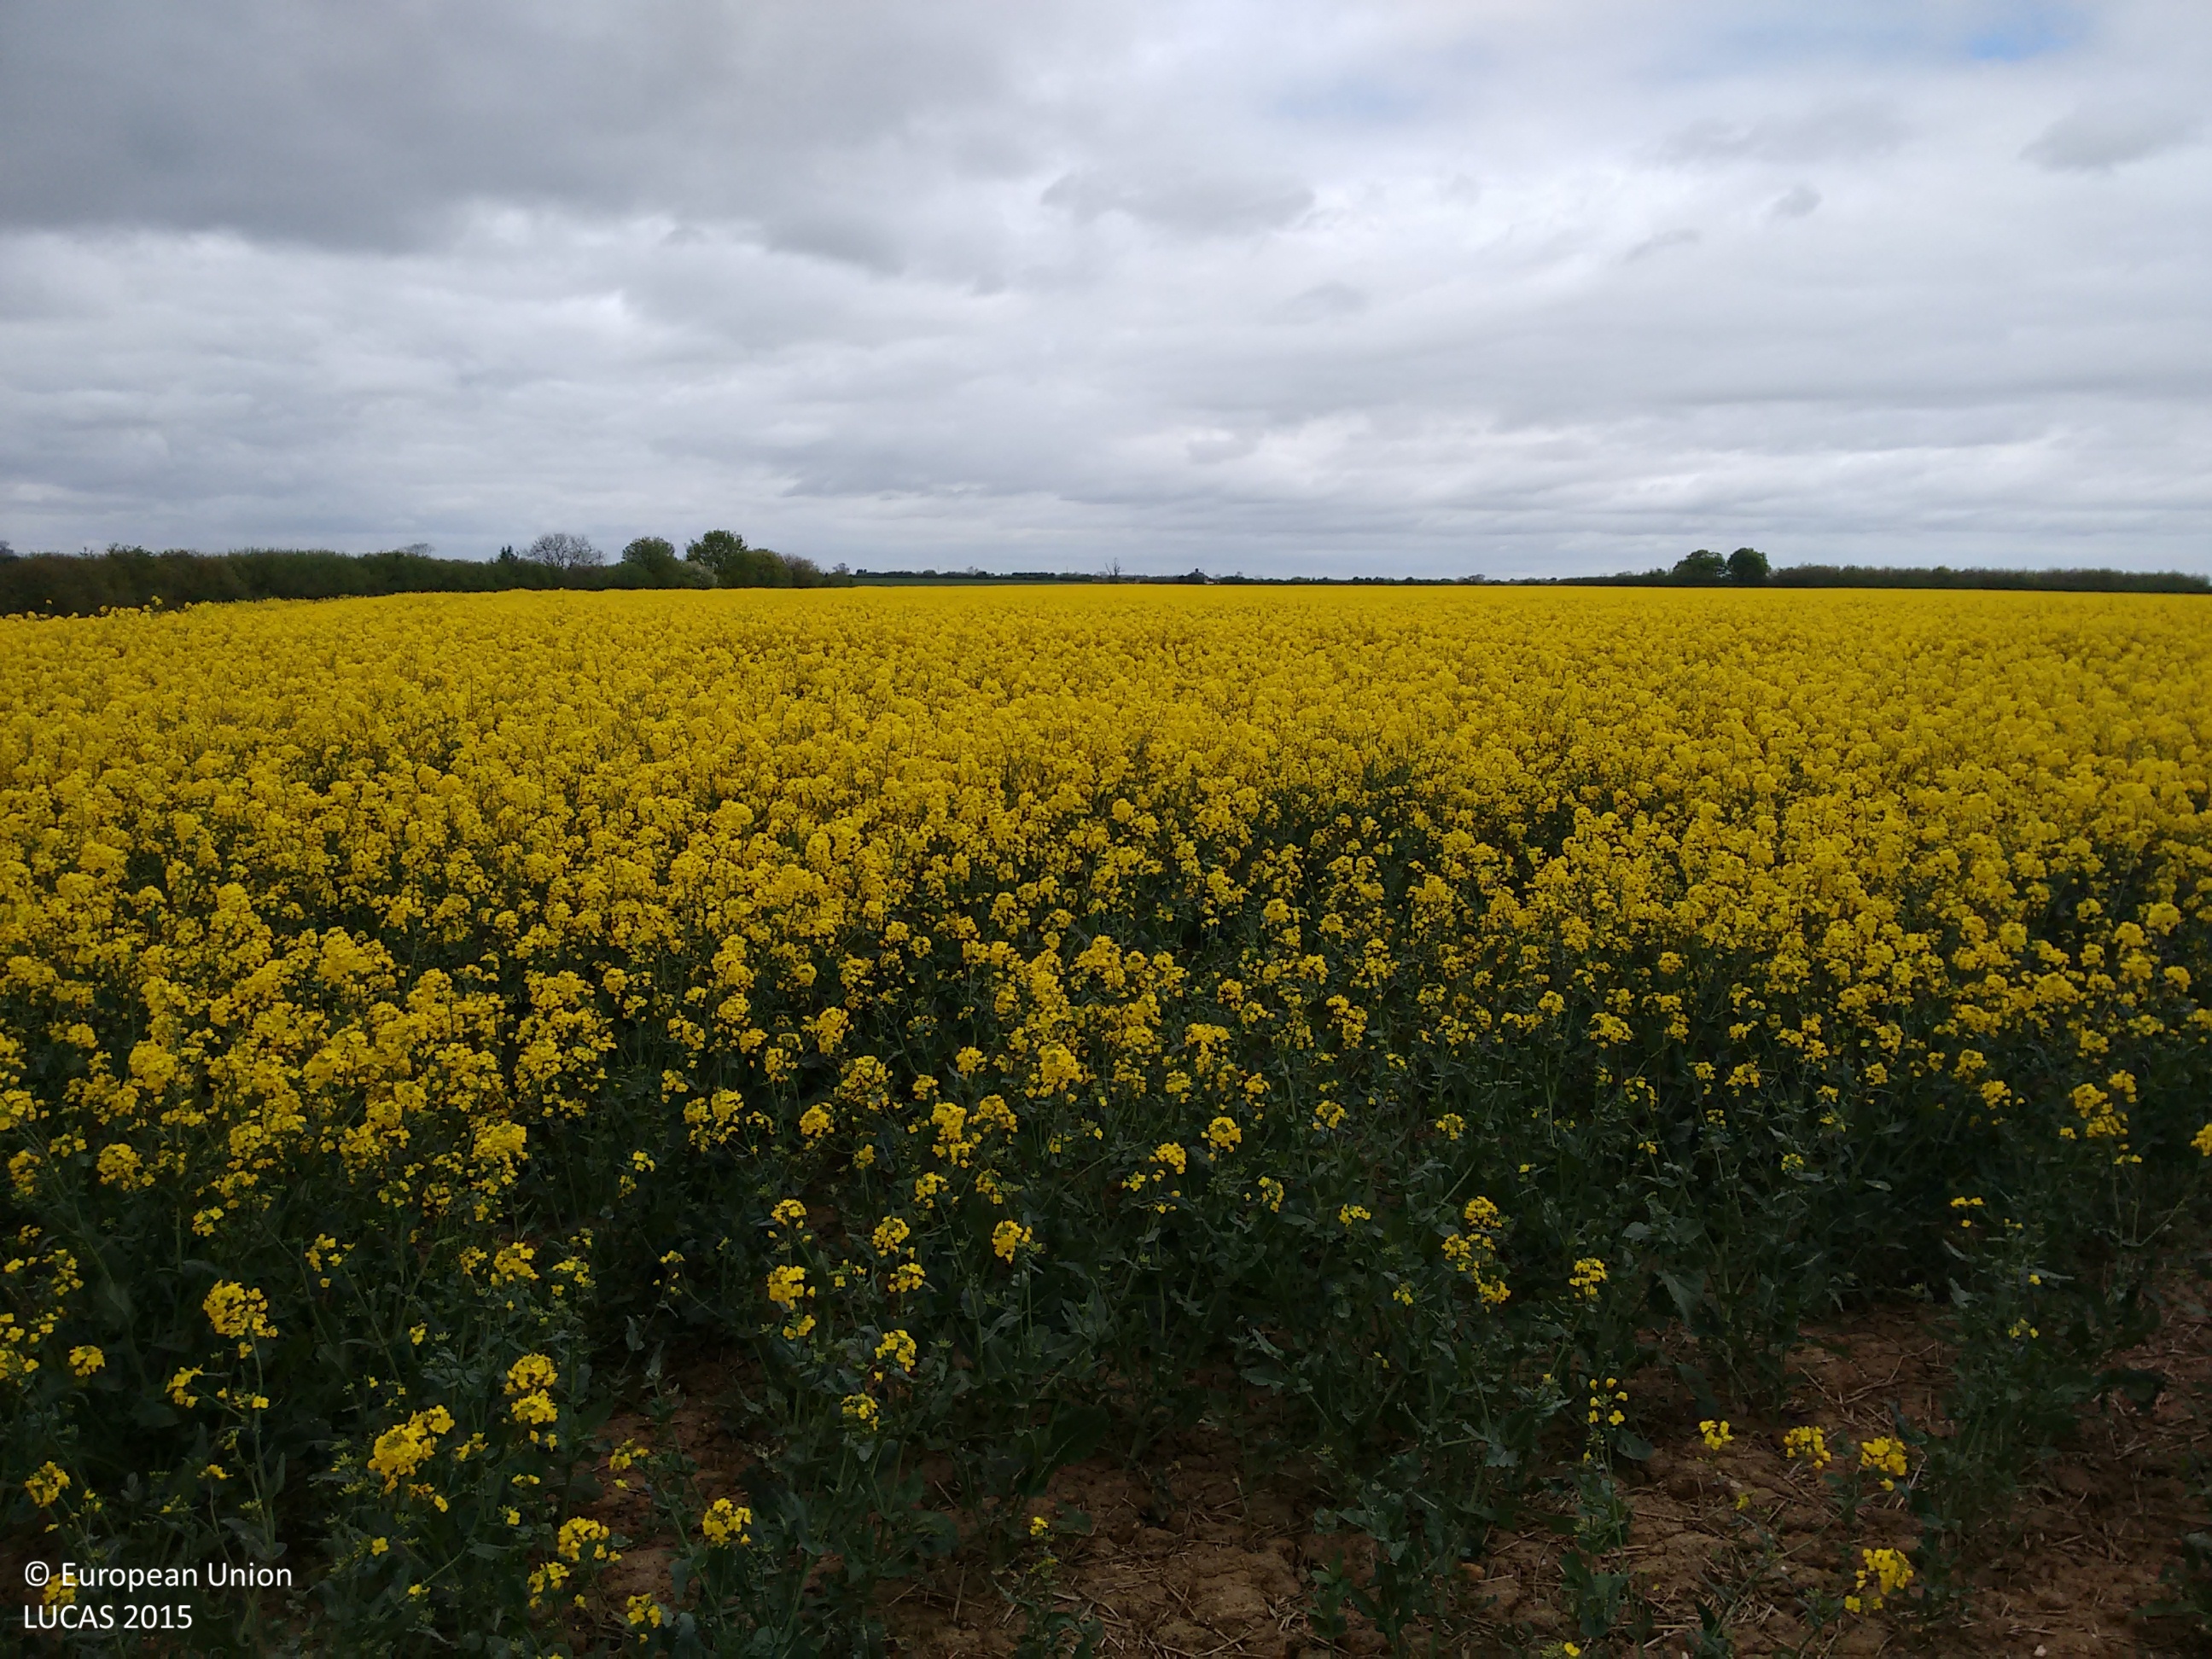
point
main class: Cropland
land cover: Rape and turnip rape
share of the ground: > 75 %
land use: Agriculture (excluding fallow land and kitchen gardens)
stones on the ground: < 10 %
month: May
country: GB
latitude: 53.8173
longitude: -0.2564
